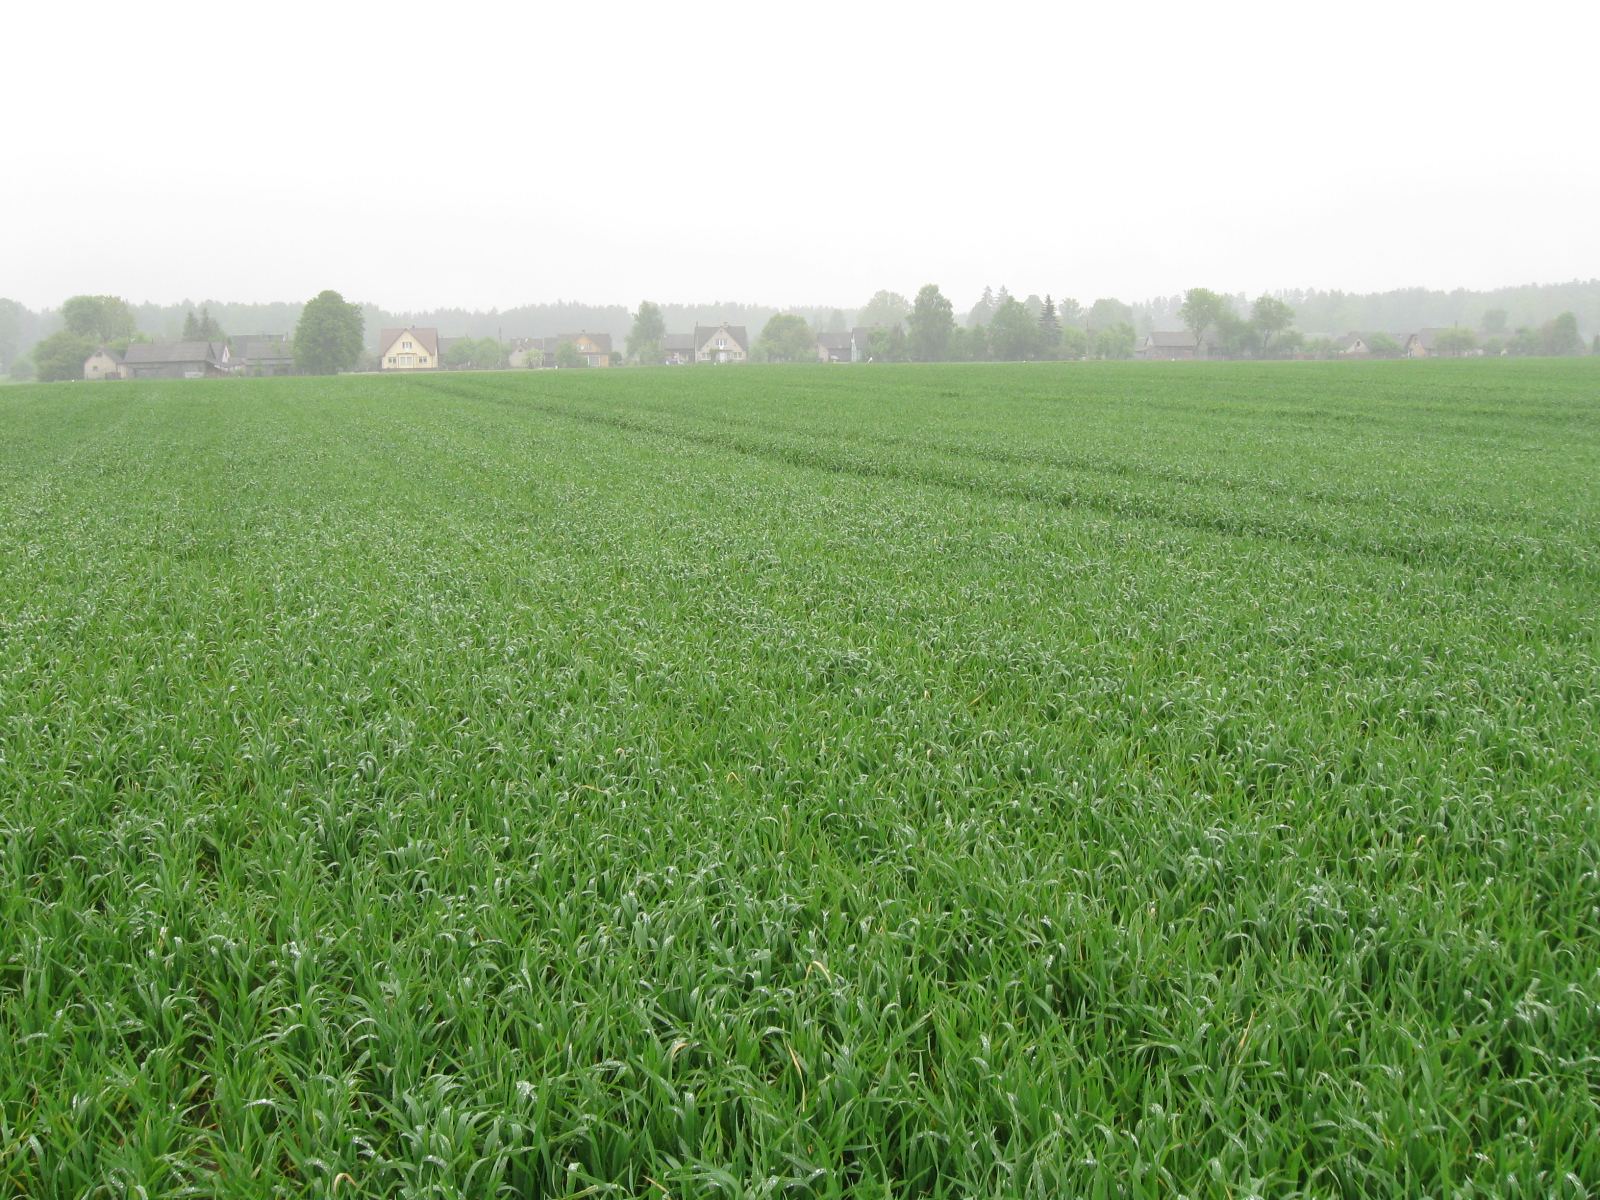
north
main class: Cropland
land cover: Common wheat
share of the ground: > 75 %
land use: Agriculture (excluding fallow land and kitchen gardens)
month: May
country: LT
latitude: 55.0405
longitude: 22.7261
